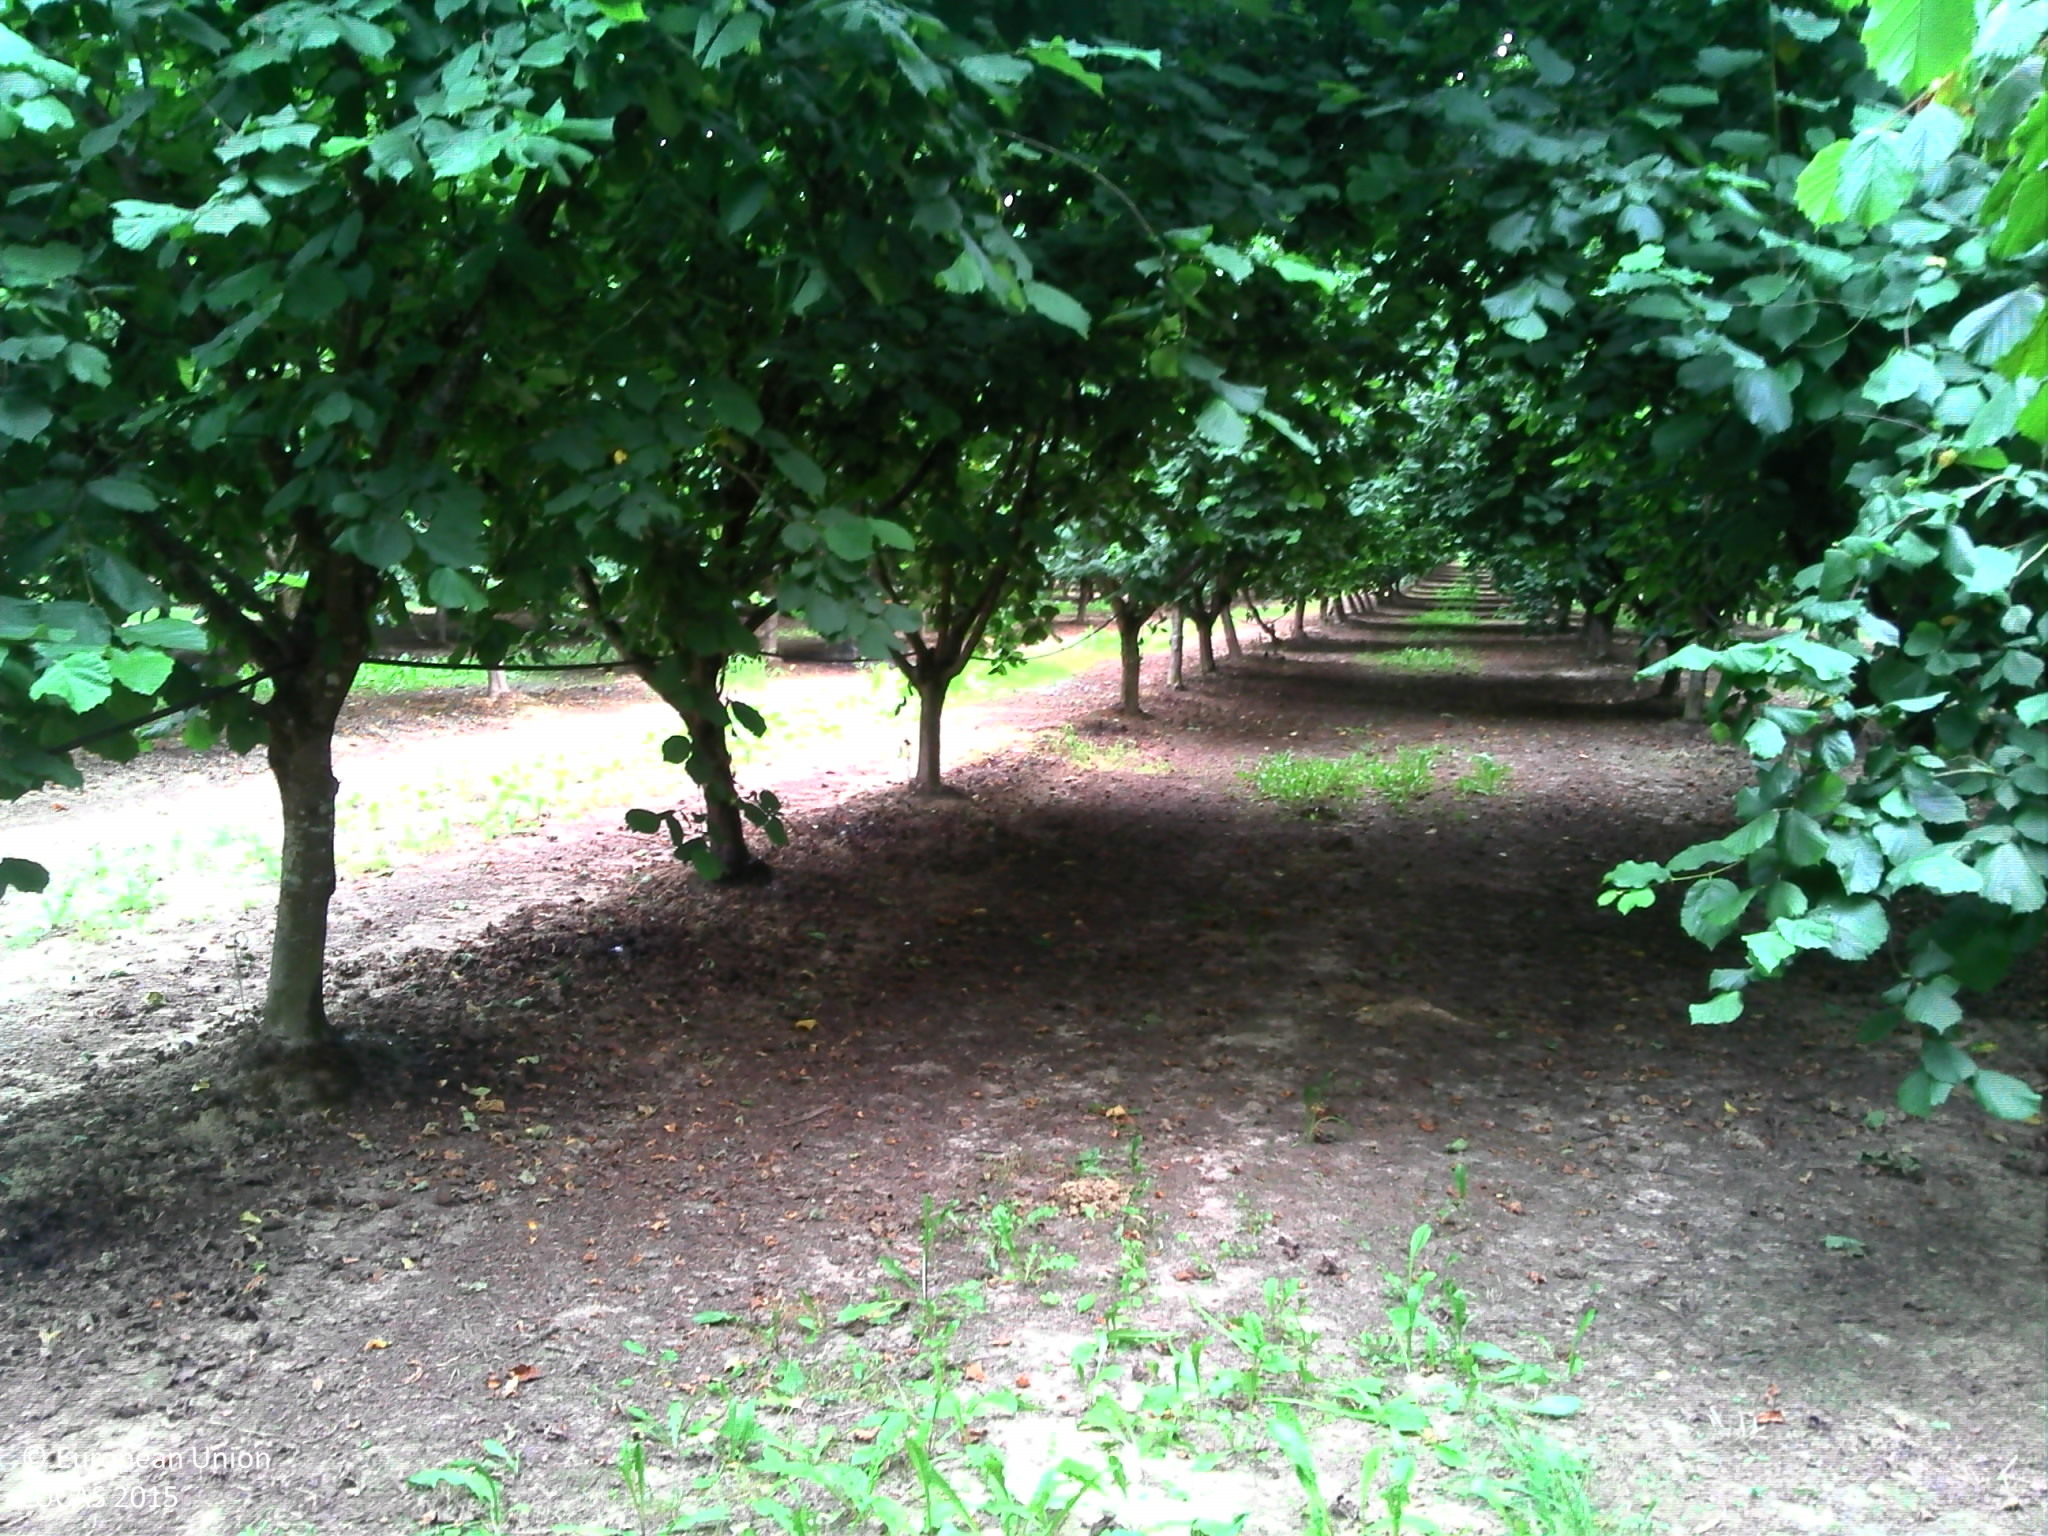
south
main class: Cropland
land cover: Nuts trees
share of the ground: > 75 %
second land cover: Spontaneously vegetated surfaces
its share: < 10 %
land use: Agriculture (excluding fallow land and kitchen gardens)
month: July
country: FR
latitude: 44.4699
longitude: 0.8306
